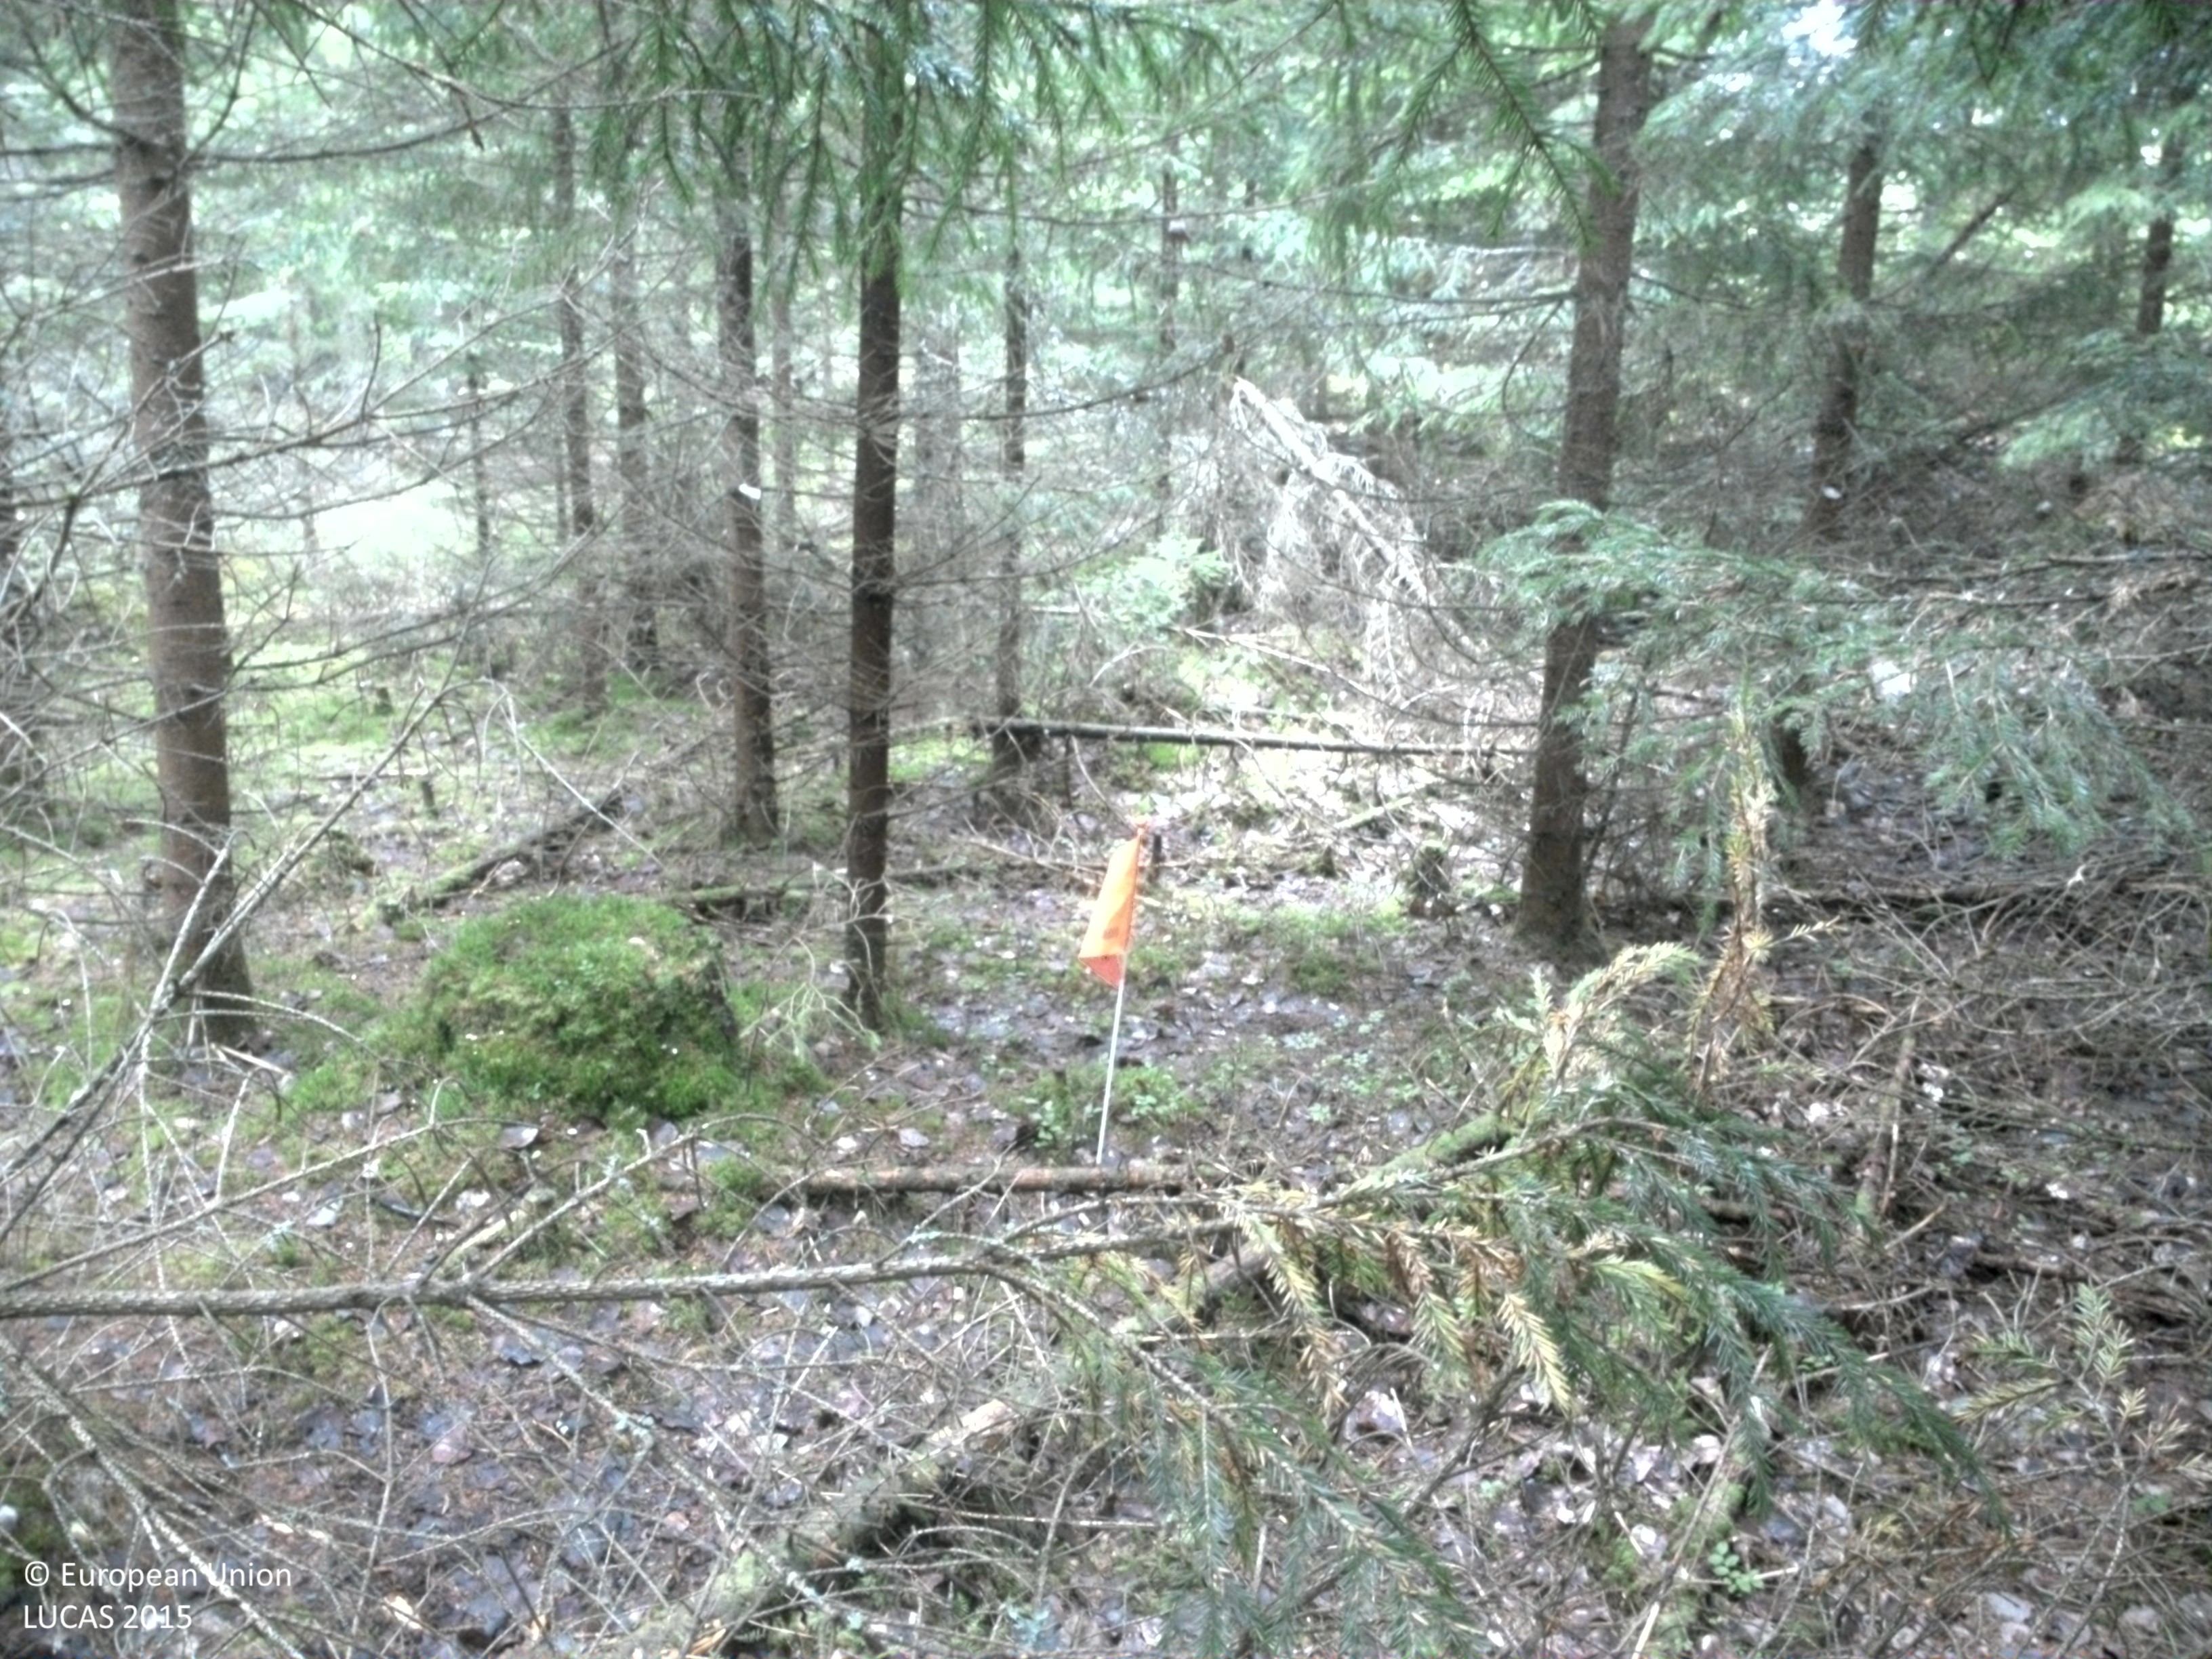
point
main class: Woodland
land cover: Spruce dominated coniferous woodland
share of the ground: > 75 %
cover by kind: coniferous forest trees 80 %, broadleaved forest trees 10 %, lichens and mosses 10 %
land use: Forestry
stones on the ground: < 10 %
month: August
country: SE
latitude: 57.8732
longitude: 13.9568
